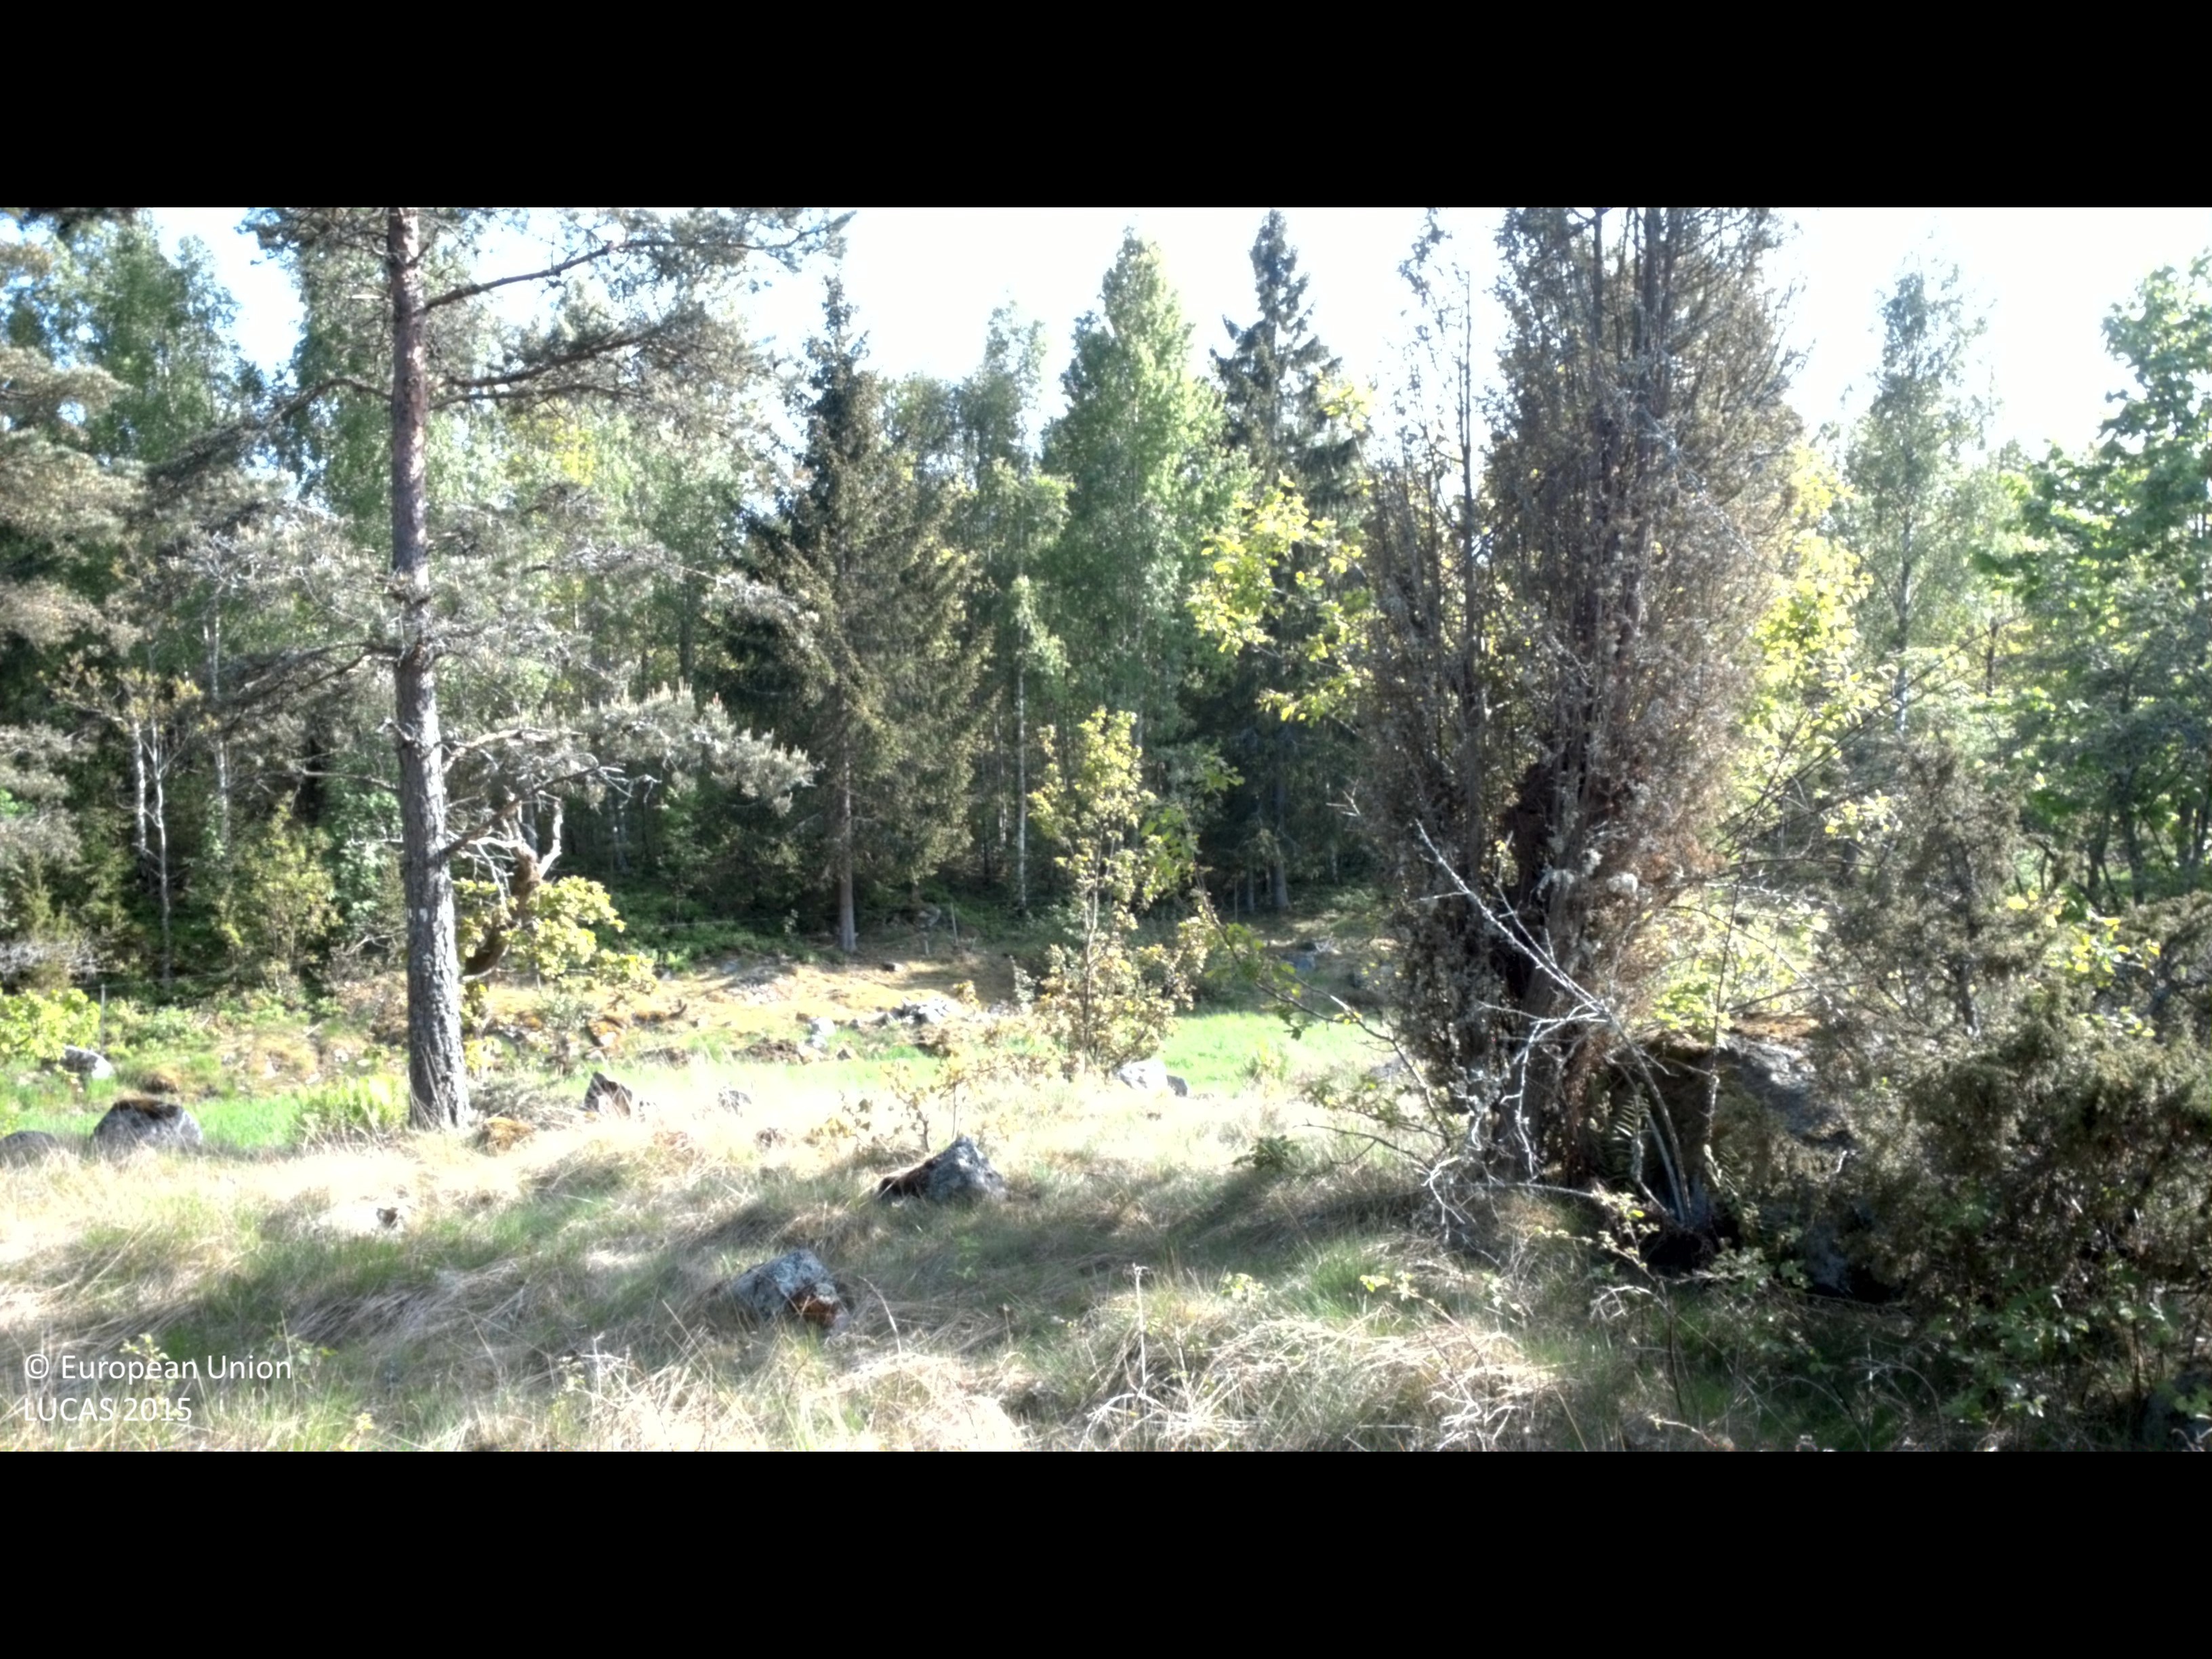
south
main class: Woodland
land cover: Pine dominated coniferous woodland
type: boreal forest
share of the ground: 50 - 75 %
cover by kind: coniferous forest trees 75 %, shrubs 10 %, broadleaved forest trees 5 %, herbaceous plants 5 %, lichens and mosses 5 %
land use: Forestry
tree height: > 5 m
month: May
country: SE
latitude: 57.3892
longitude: 16.6046
